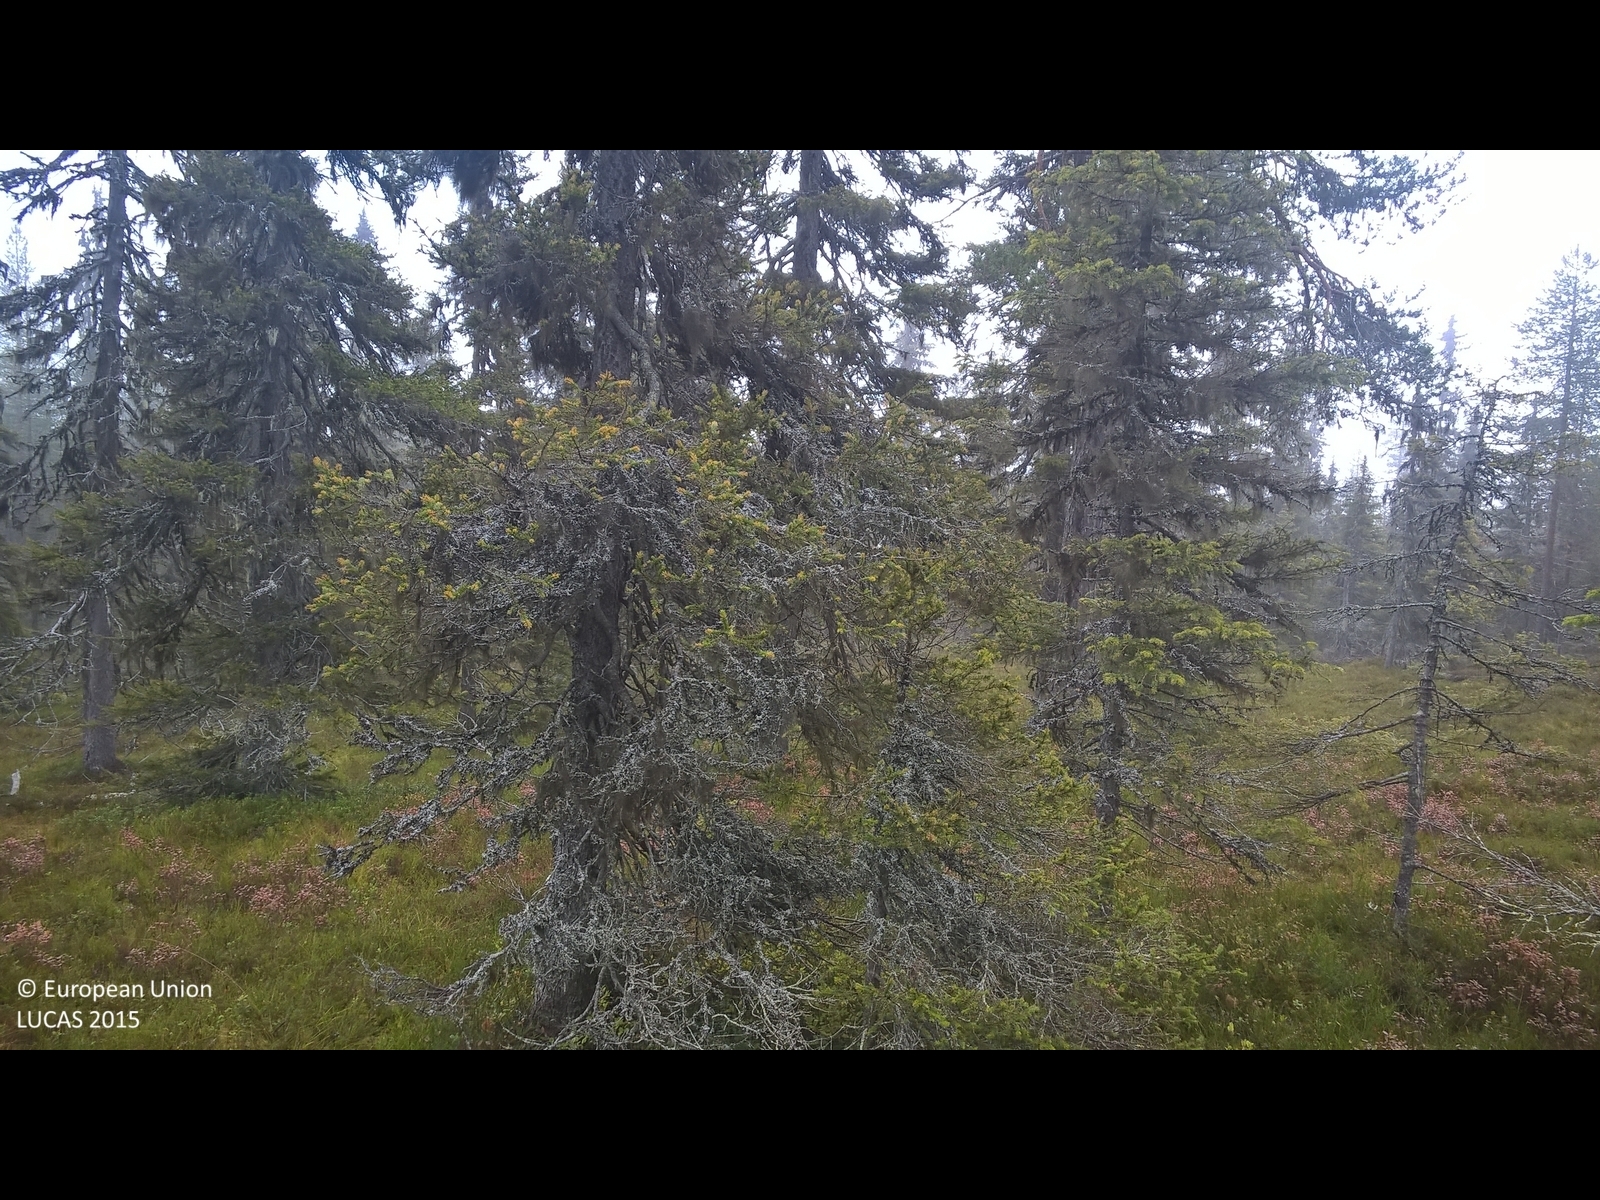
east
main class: Woodland
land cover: Spruce dominated coniferous woodland
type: boreal forest
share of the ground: > 75 %
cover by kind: coniferous forest trees 80 %, shrubs 15 %, lichens and mosses 5 %
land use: Forestry
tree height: > 5 m
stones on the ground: < 10 %
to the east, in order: Spruce dominated coniferous woodland; Broadleaved woodland
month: October
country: SE
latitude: 65.6458
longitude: 18.8044
